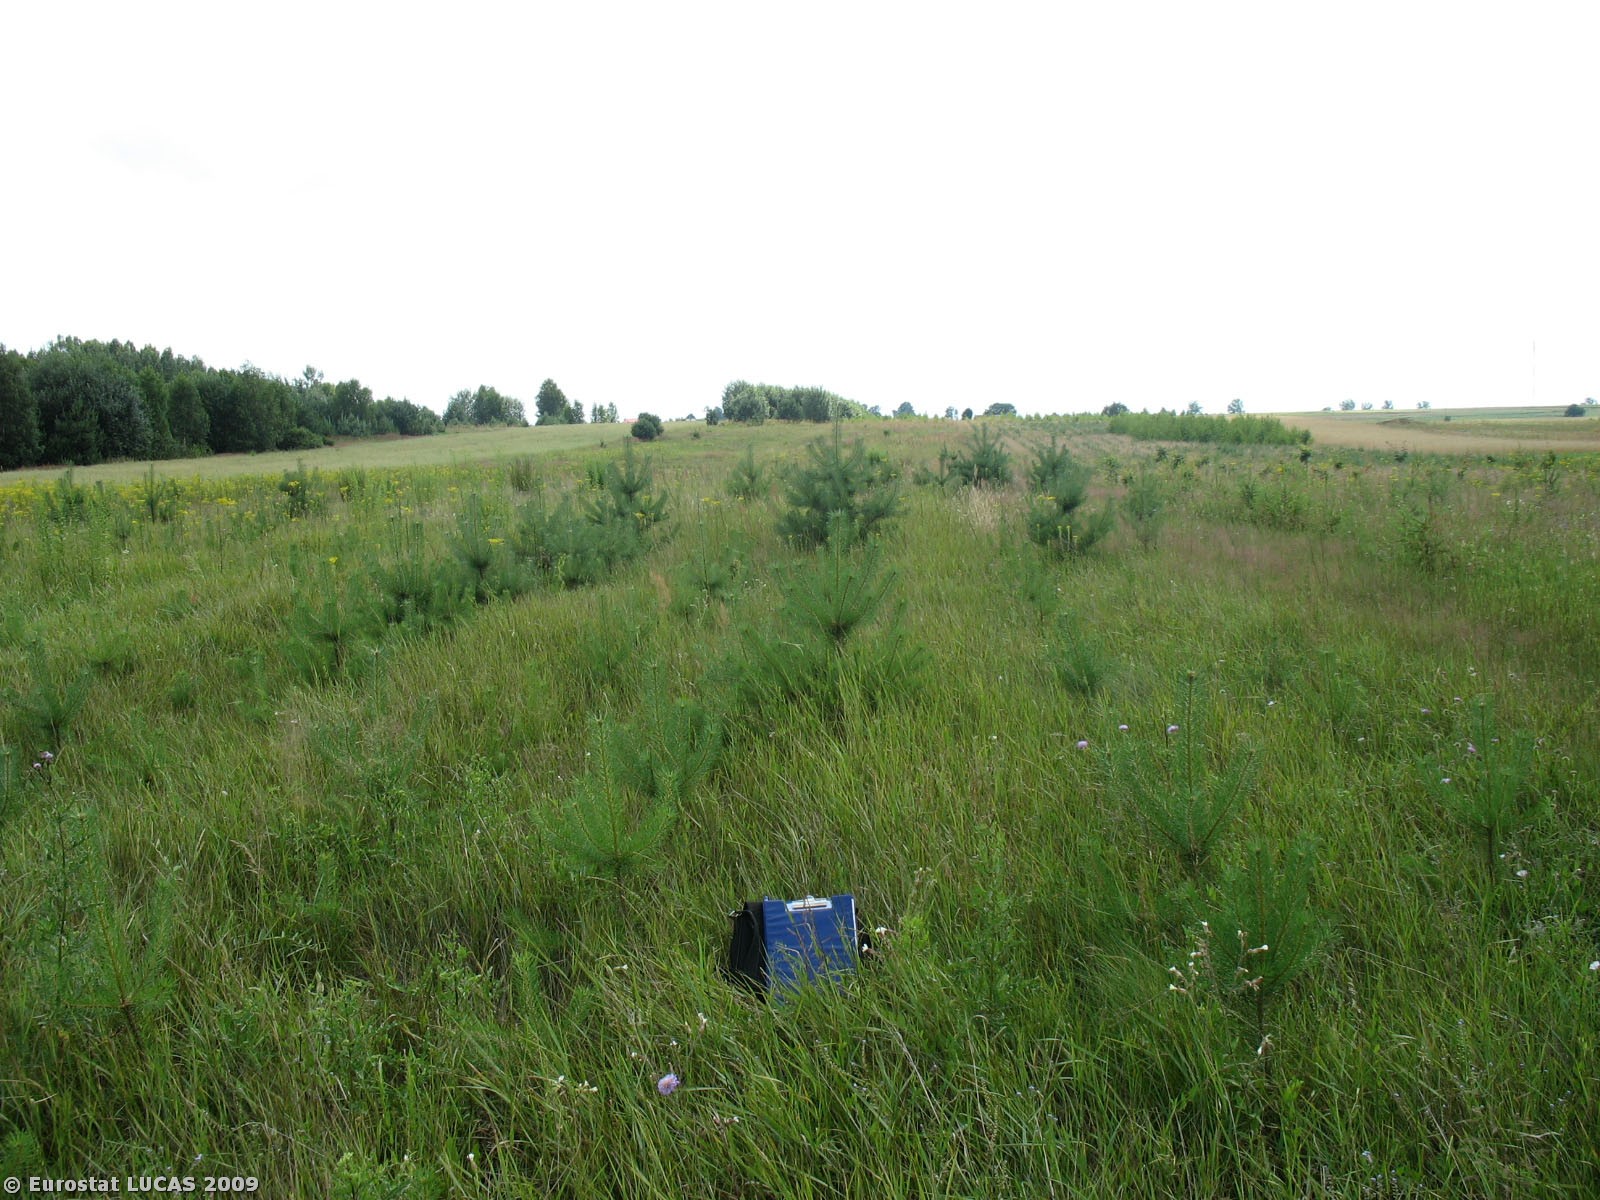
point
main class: Woodland
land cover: Coniferous woodland
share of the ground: 10 - 25 %
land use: Forestry
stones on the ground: < 10 %
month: July
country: PL
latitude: 50.8325
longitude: 20.1867
